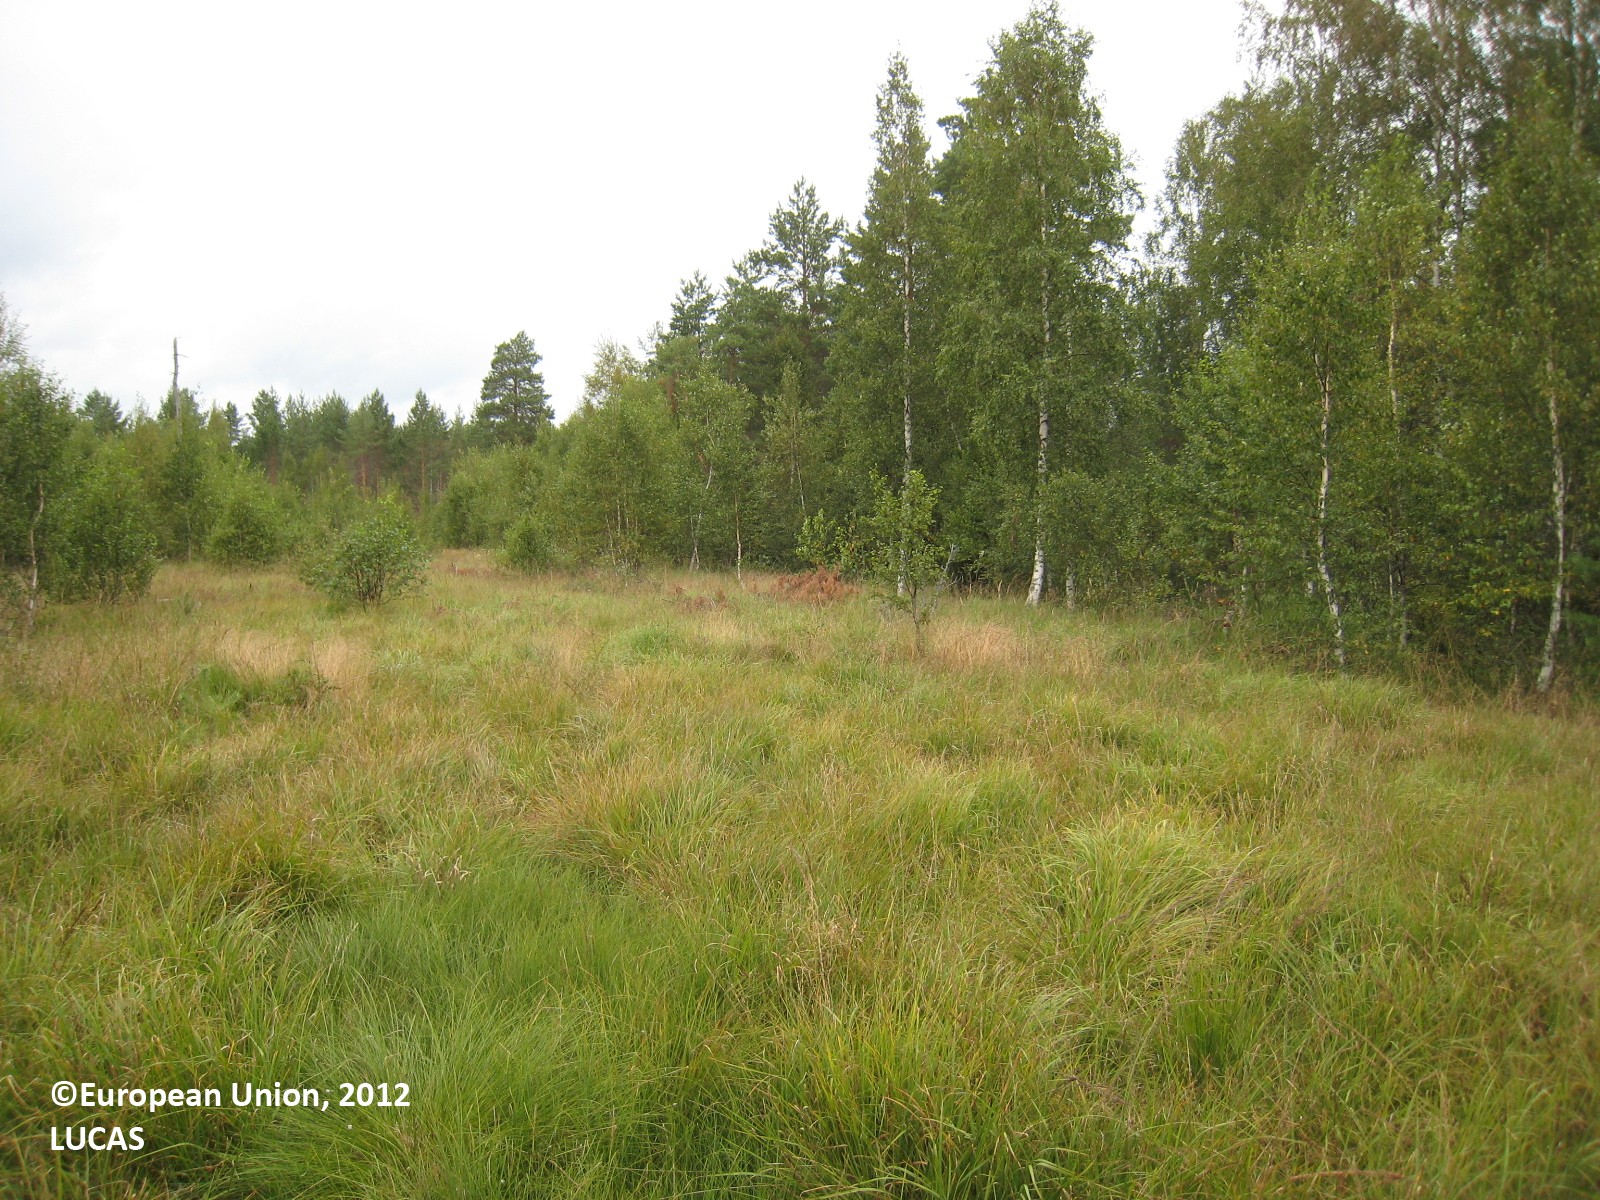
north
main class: Grassland
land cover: Grassland with sparse tree/shrub cover
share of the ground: > 75 %
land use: Forestry
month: August
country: FI
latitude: 61.8548
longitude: 26.0373
